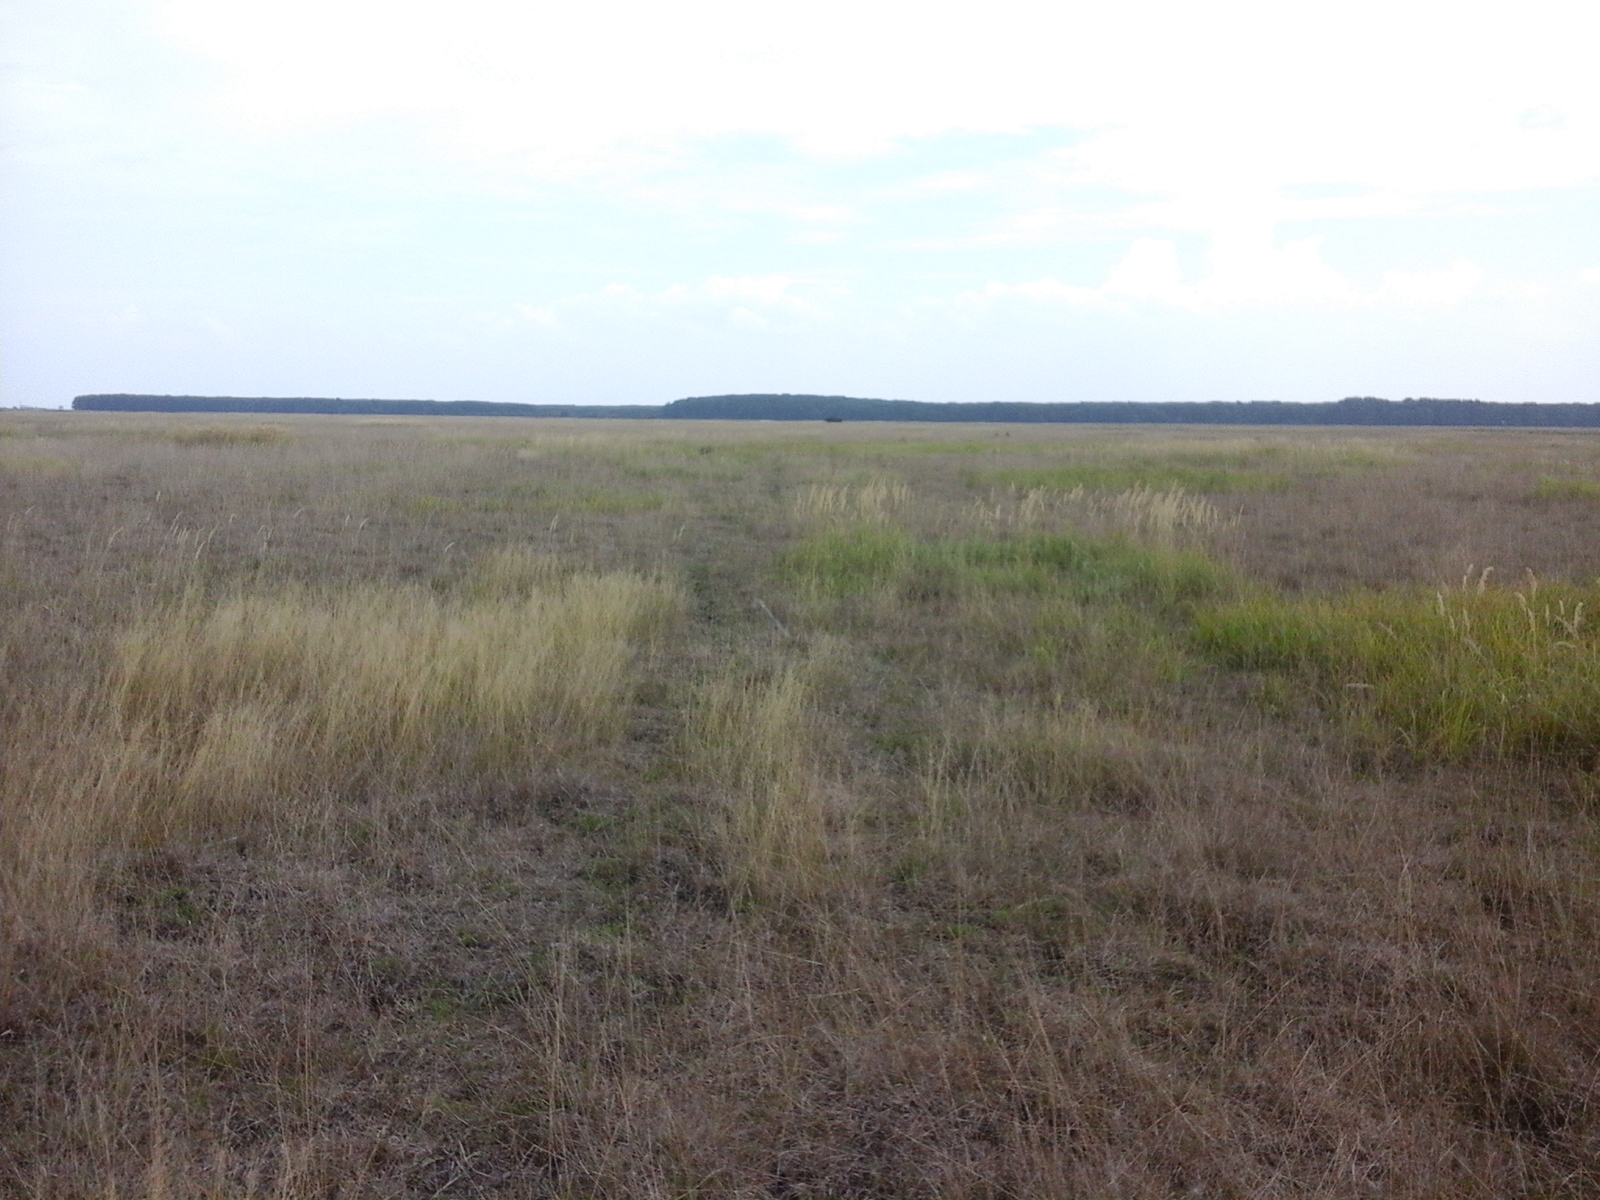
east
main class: Grassland
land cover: Grassland without tree/shrub cover
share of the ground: > 75 %
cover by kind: herbaceous plants 100 %
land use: Agriculture (excluding fallow land and kitchen gardens)
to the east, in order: Grassland without tree/shrub cover
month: August
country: RO
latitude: 46.5701
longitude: 21.4537
